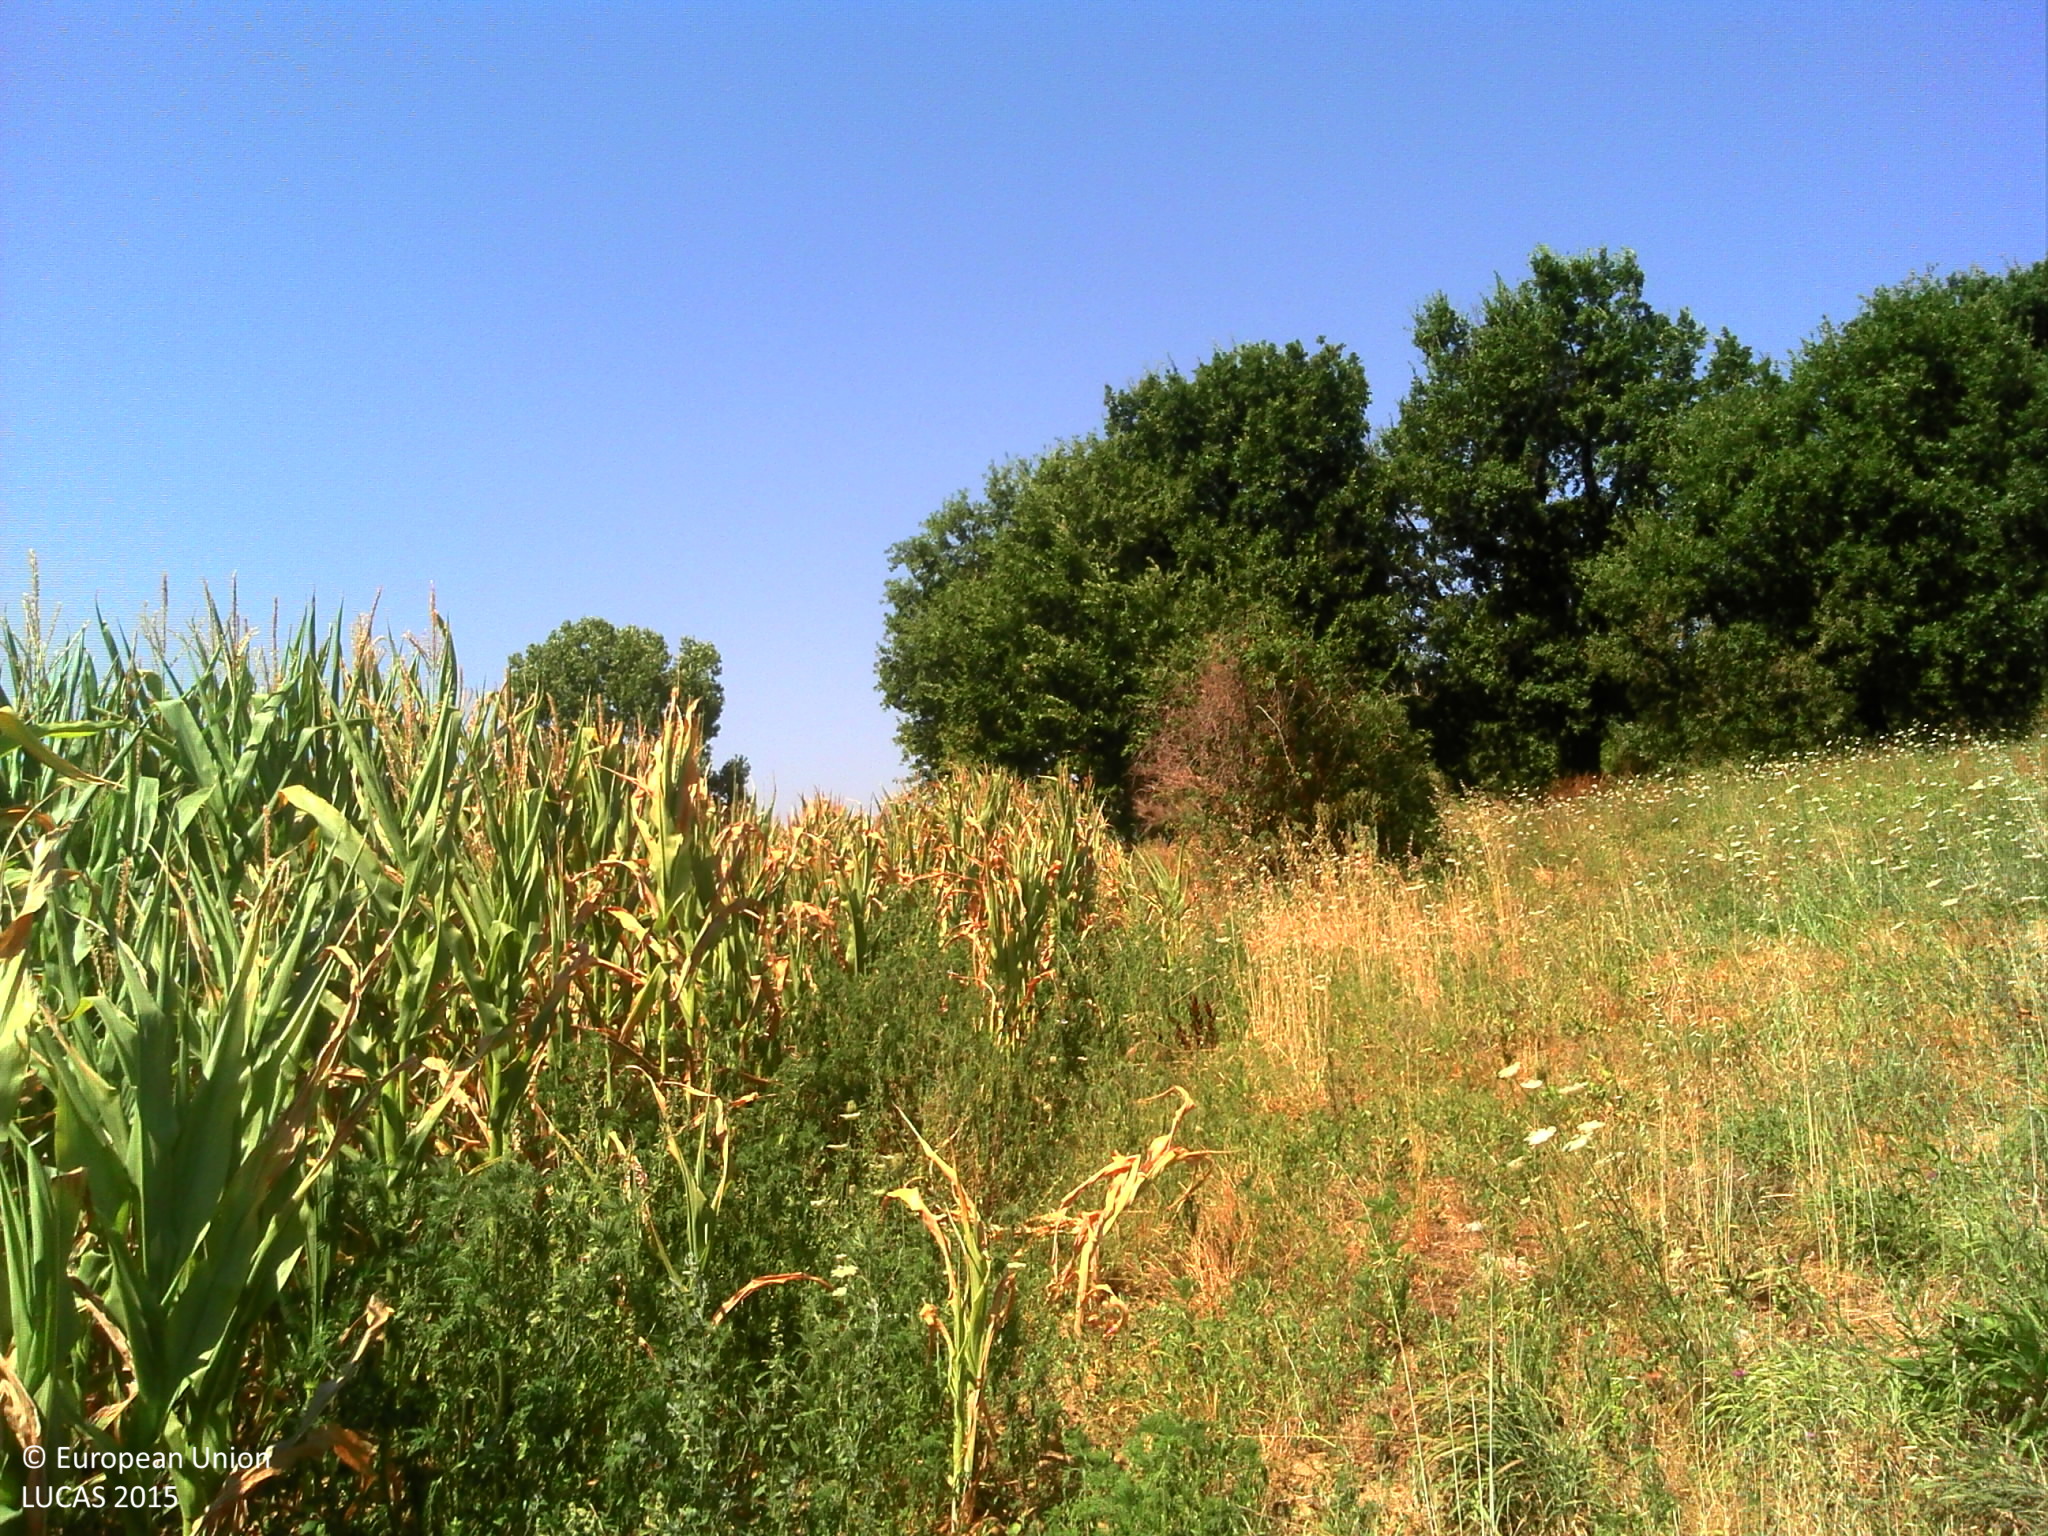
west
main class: Cropland
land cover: Maize
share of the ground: > 75 %
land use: Agriculture (excluding fallow land and kitchen gardens)
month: July
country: FR
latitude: 45.2006
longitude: 4.9001
